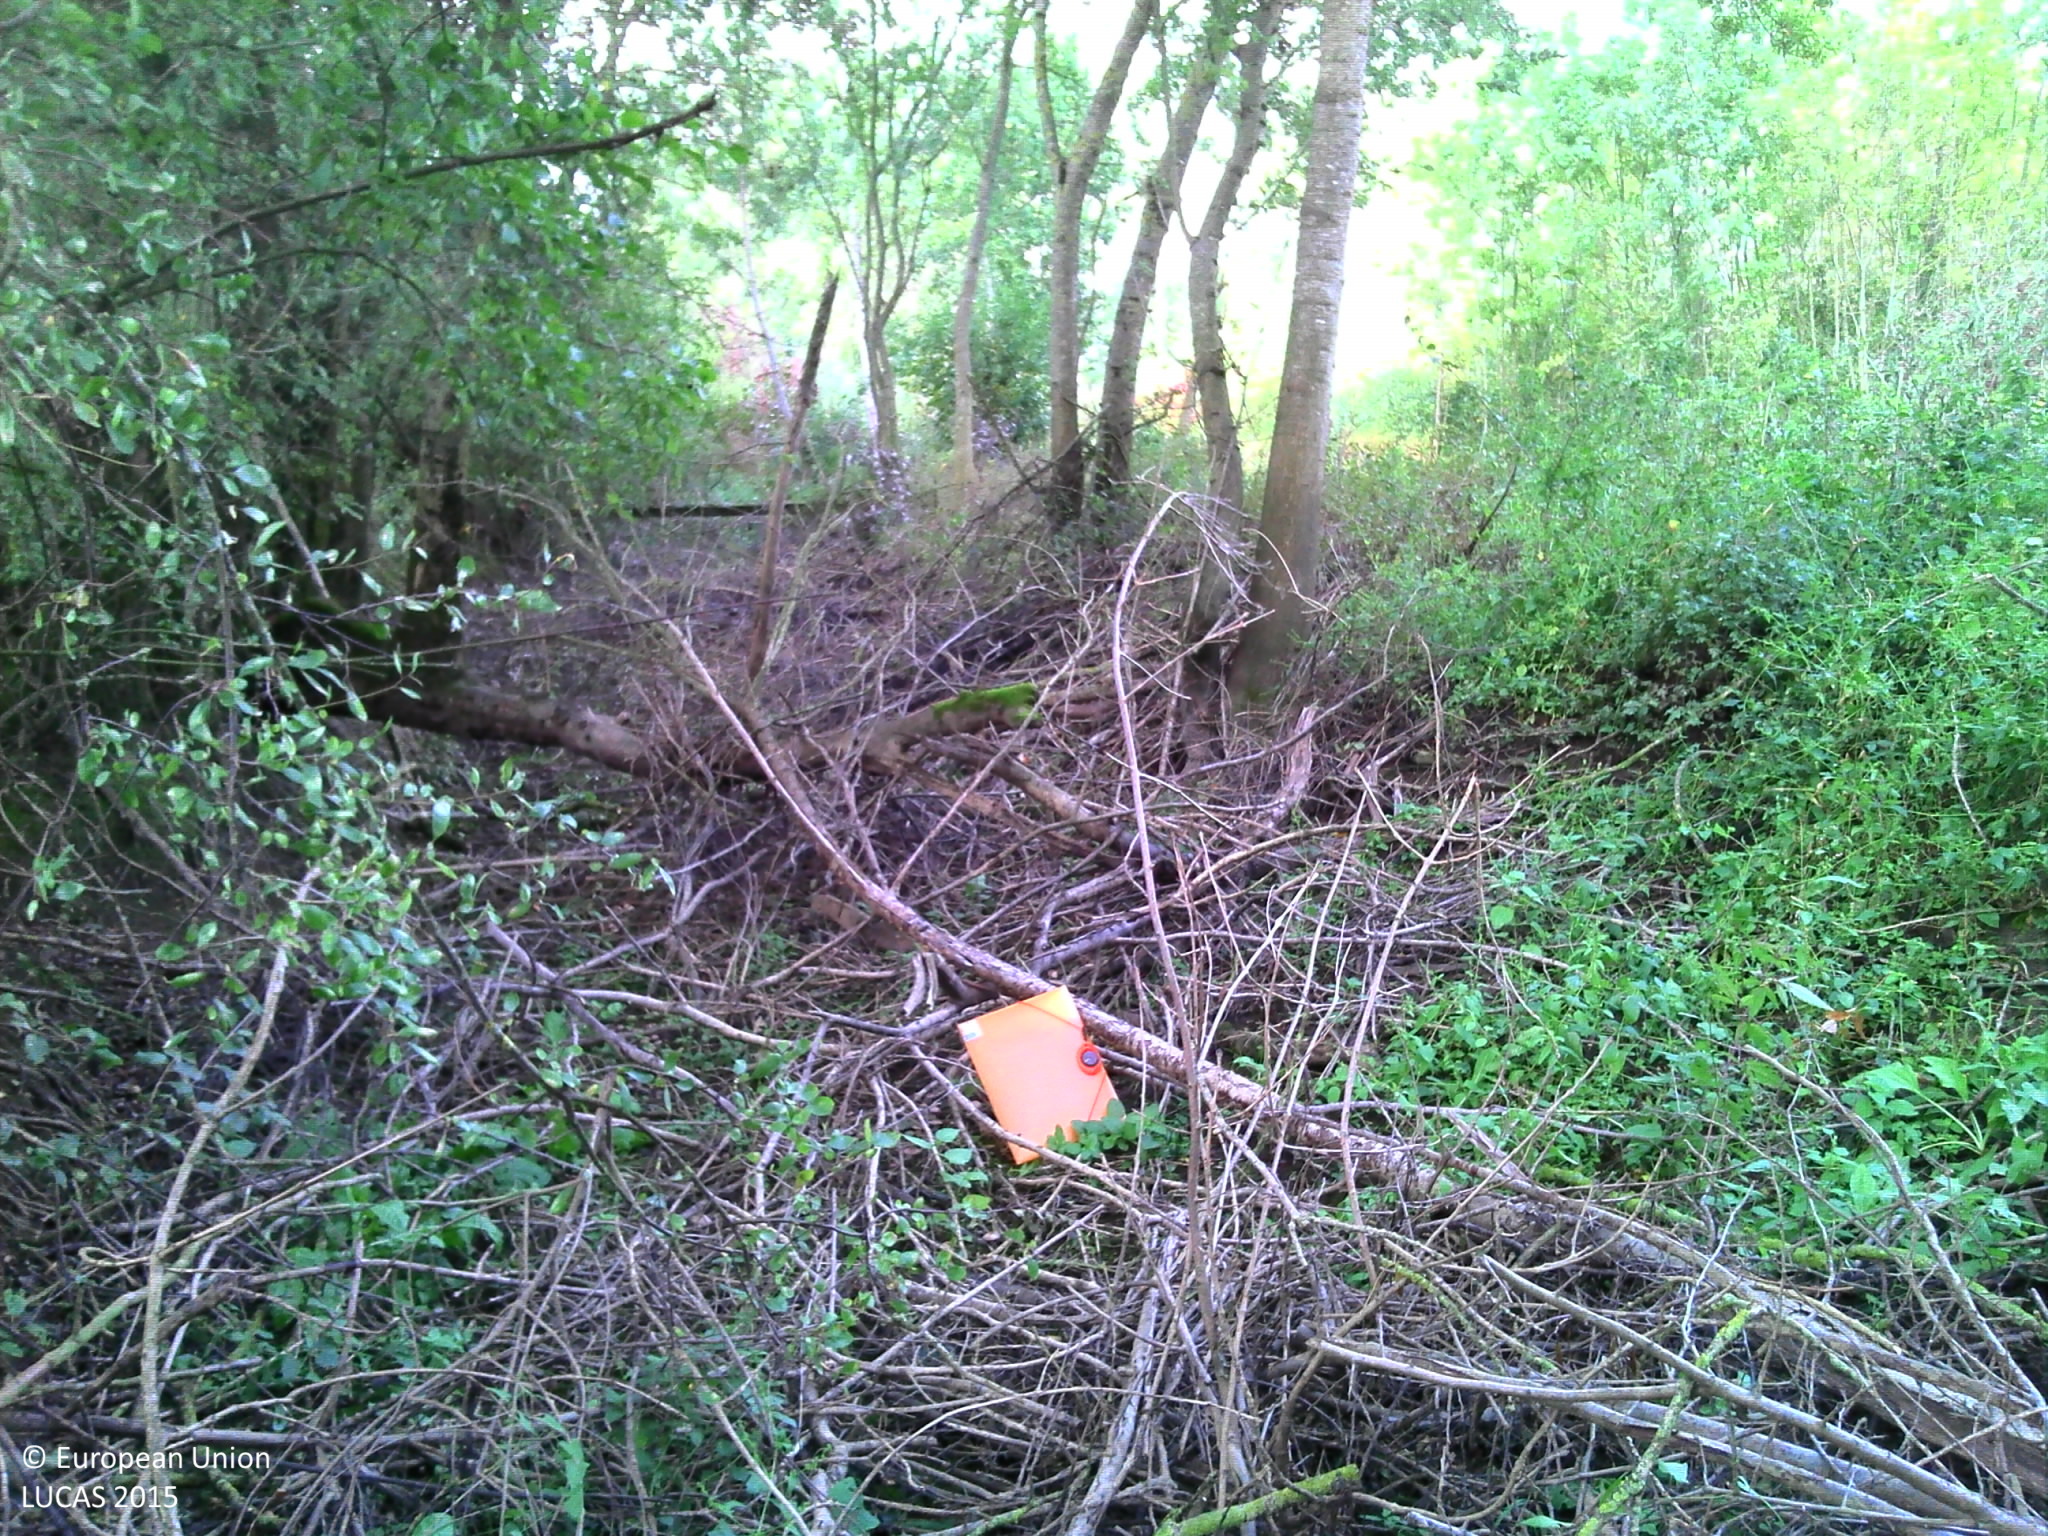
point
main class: Grassland
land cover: Grassland without tree/shrub cover
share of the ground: > 75 %
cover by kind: herbaceous plants 100 %
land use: Agriculture (excluding fallow land and kitchen gardens)
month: September
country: FR
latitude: 46.9737
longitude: 4.9930
